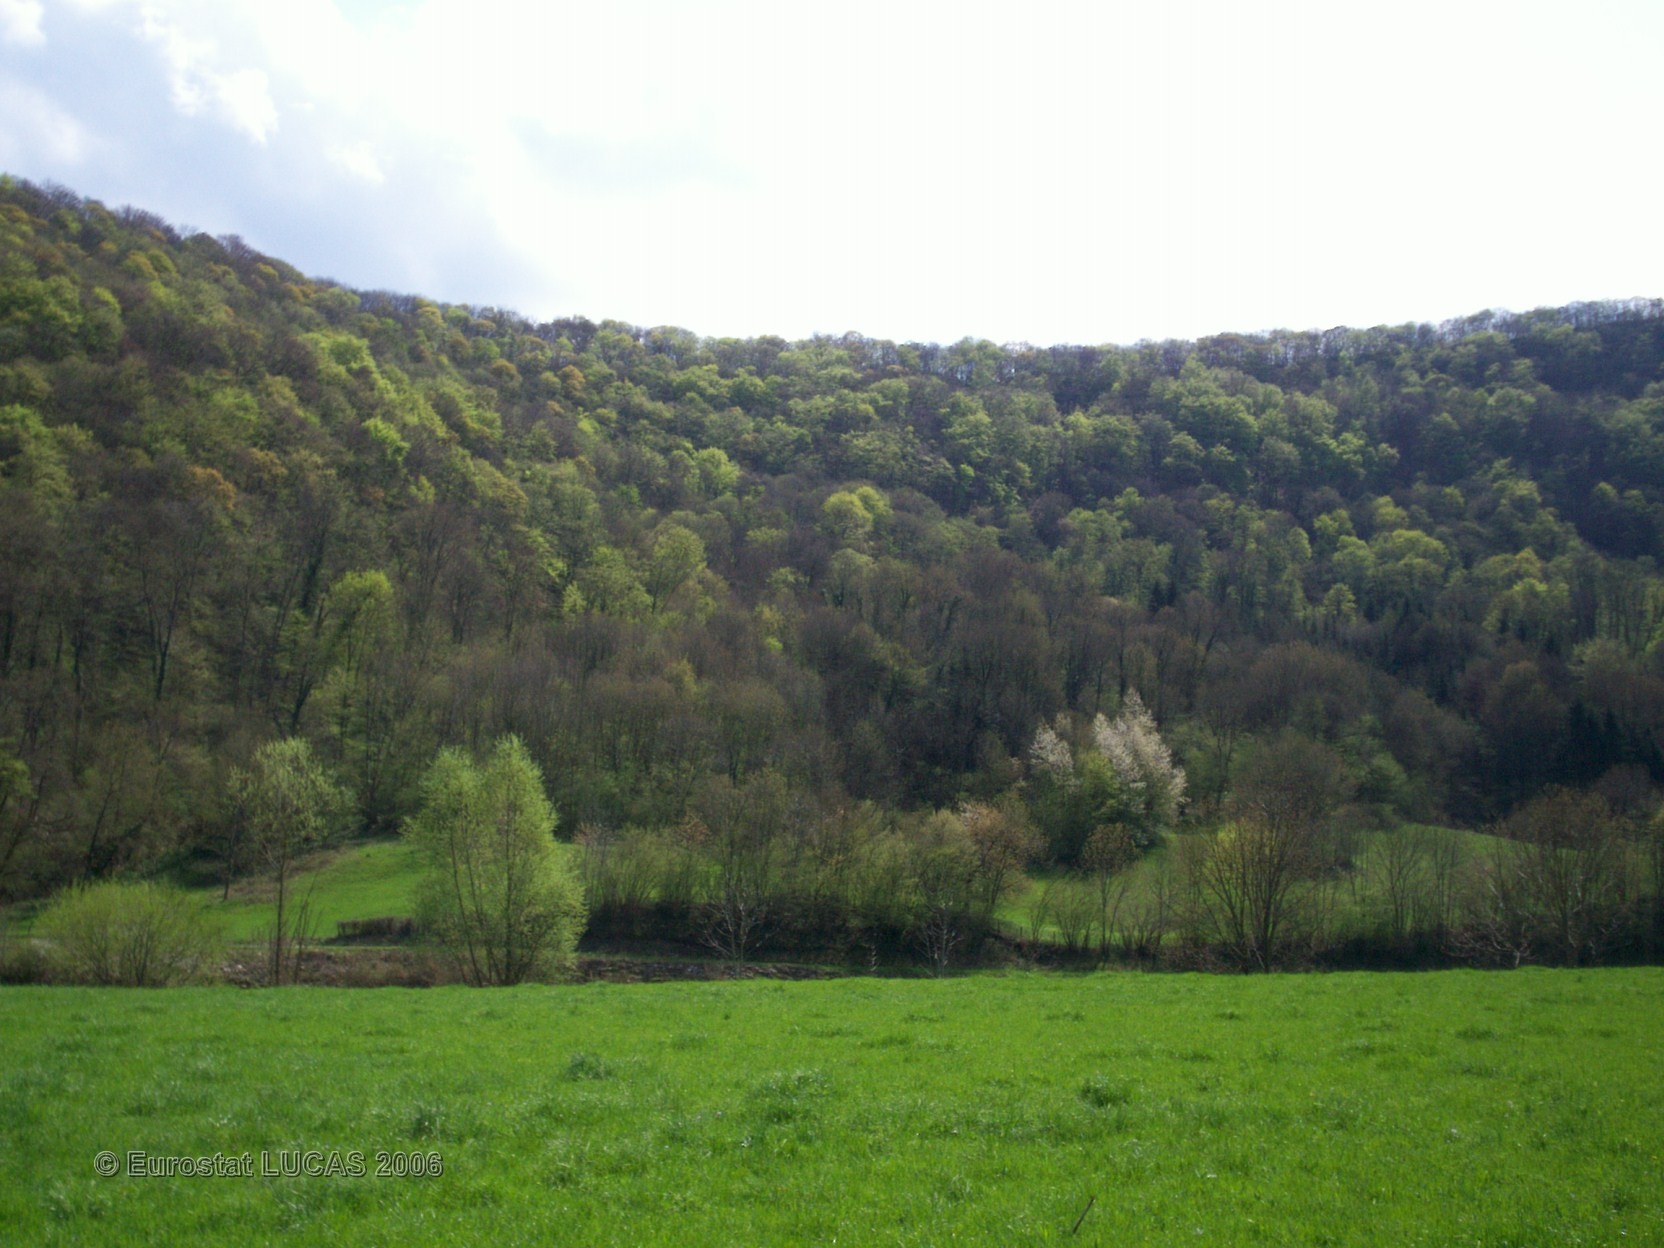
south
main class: Grassland
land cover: Grassland without tree/shrub cover
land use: Agriculture (excluding fallow land and kitchen gardens)
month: April
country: FR
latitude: 47.3537
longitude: 6.3876
